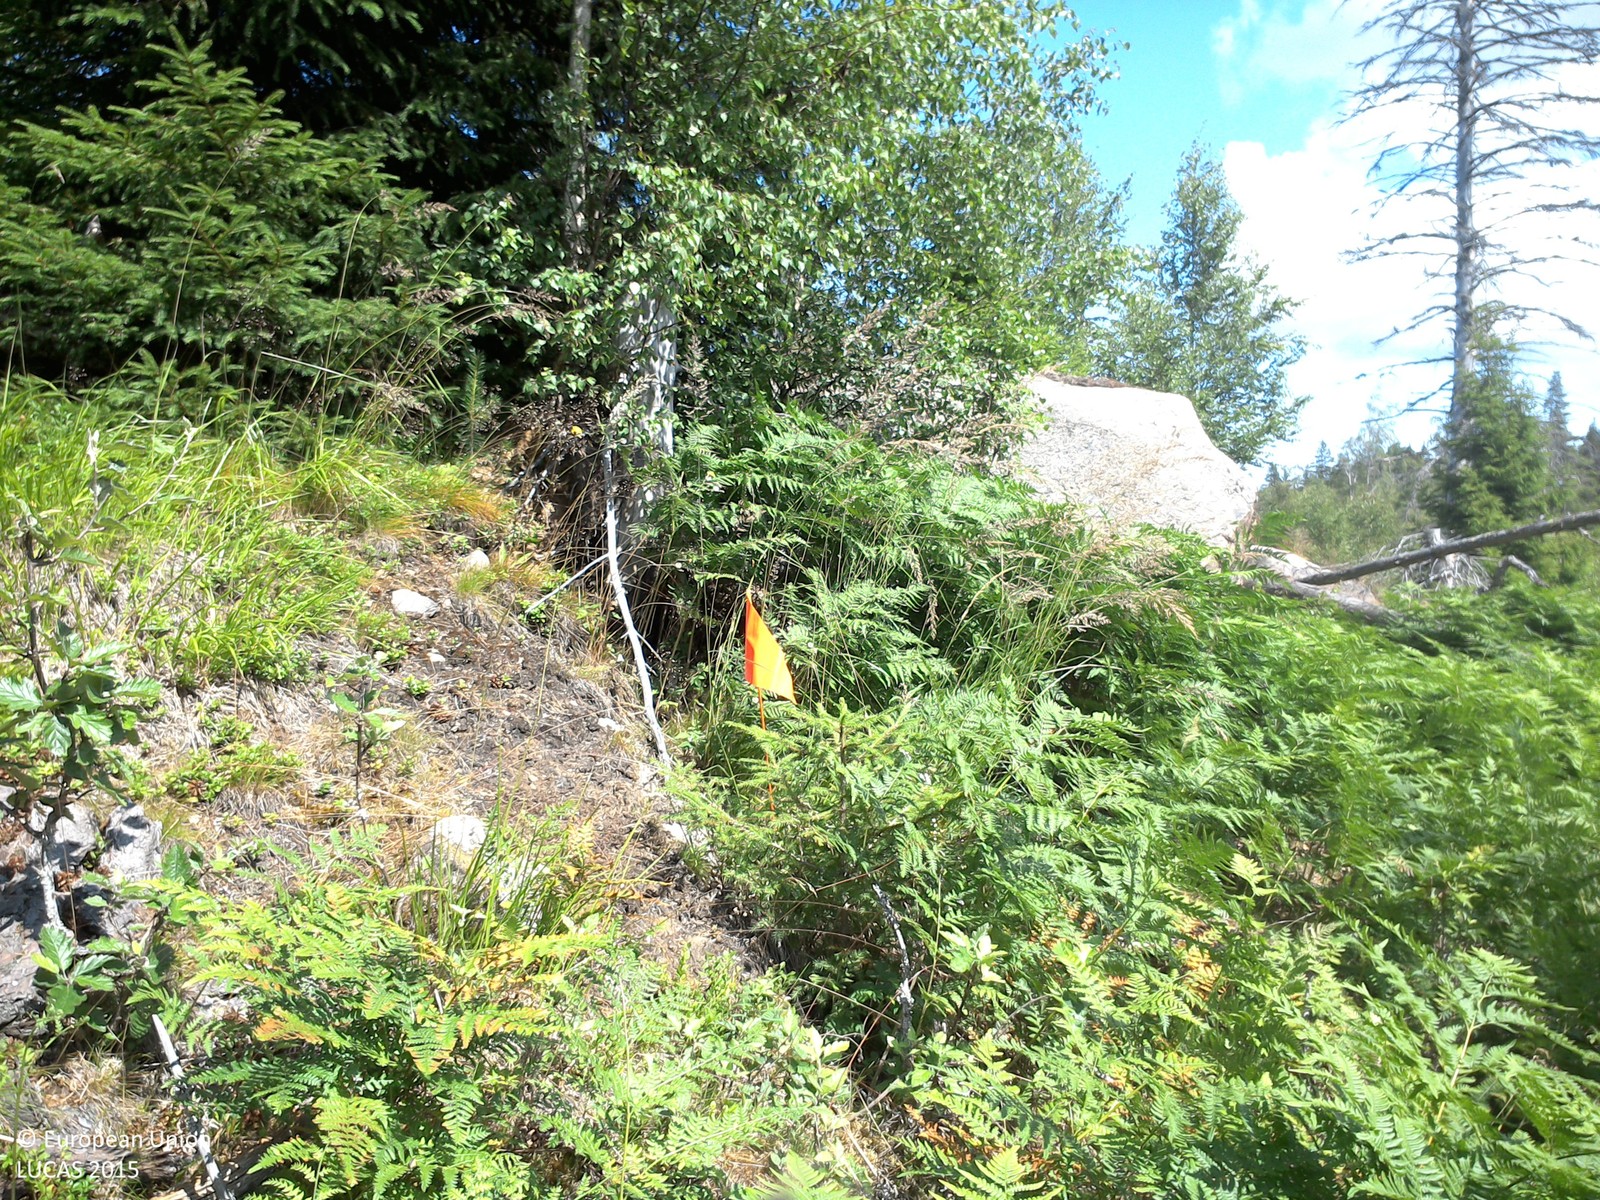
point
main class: Woodland
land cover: Spruce dominated mixed woodland
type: boreal forest
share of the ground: 50 - 75 %
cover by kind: coniferous forest trees 50 %, broadleaved forest trees 25 %, herbaceous plants 15 %, lichens and mosses 10 %
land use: Forestry
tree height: > 5 m
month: July
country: SE
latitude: 58.0524
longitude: 14.5525
